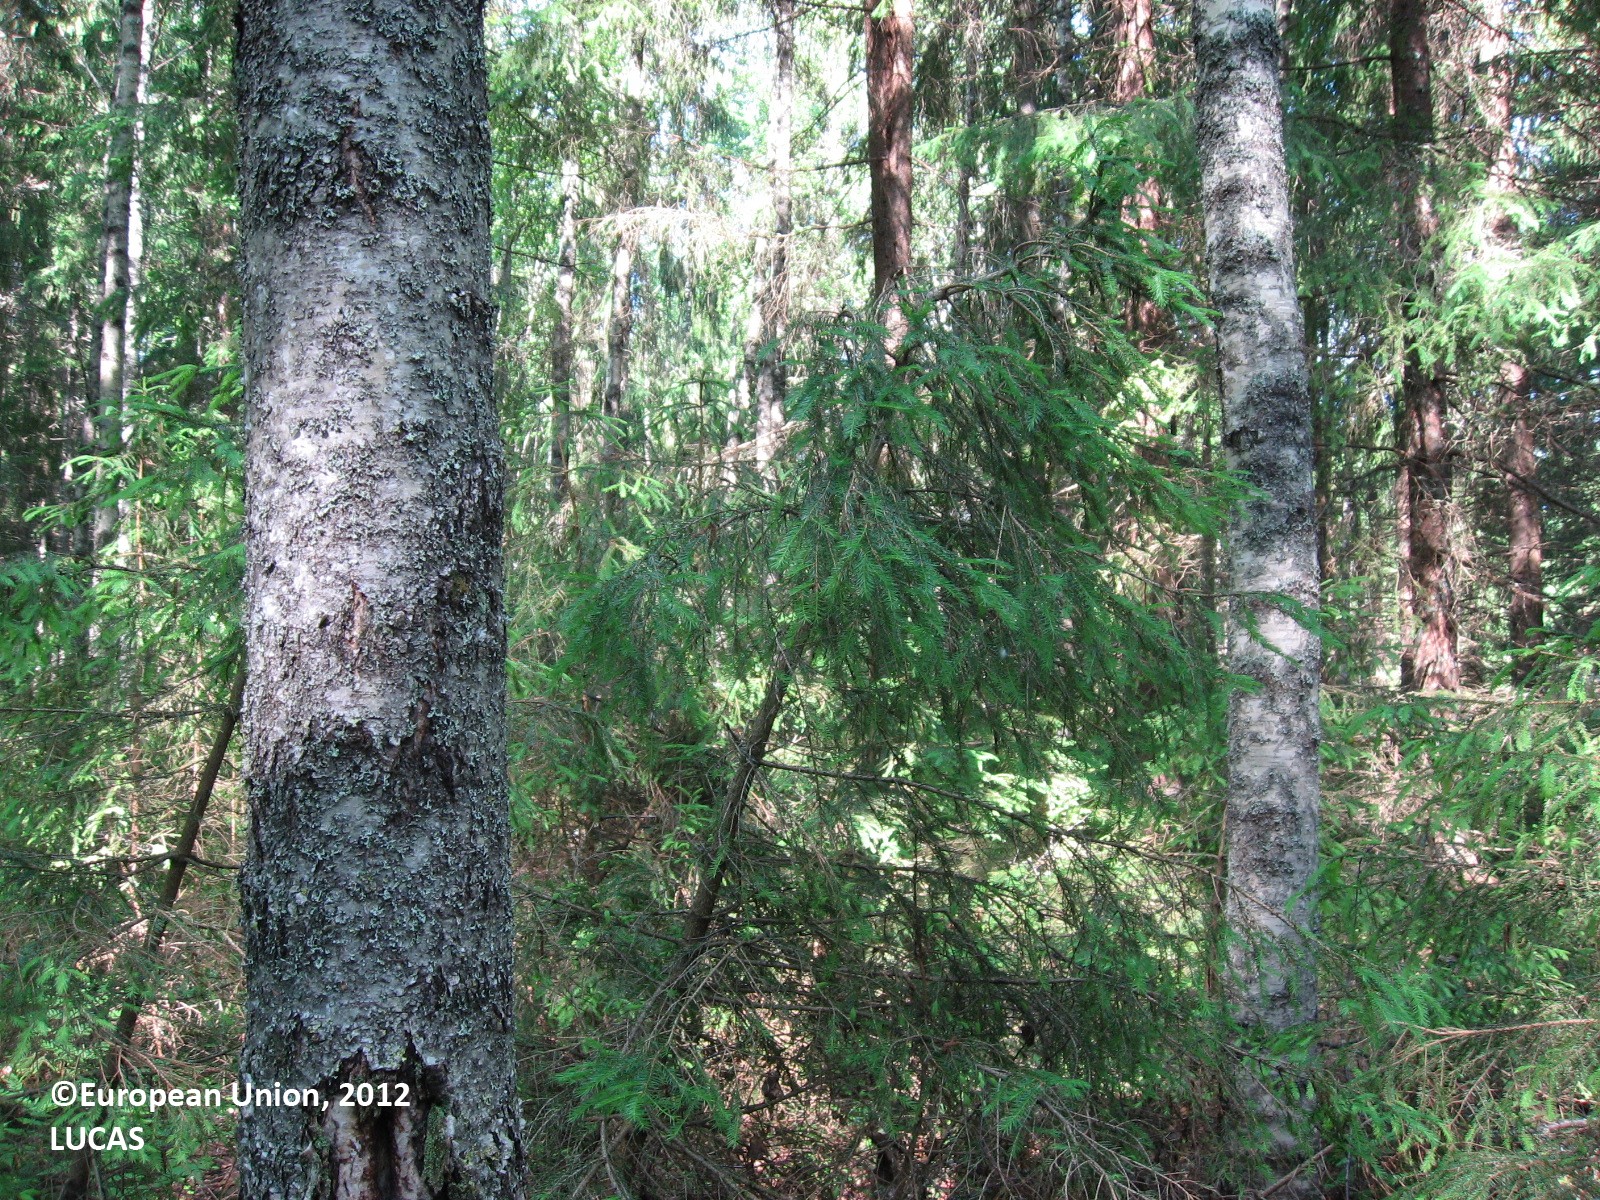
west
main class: Woodland
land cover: Spruce dominated mixed woodland
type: boreal forest
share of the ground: > 75 %
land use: Forestry
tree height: > 5 m
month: June
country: FI
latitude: 60.4618
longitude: 26.4292
